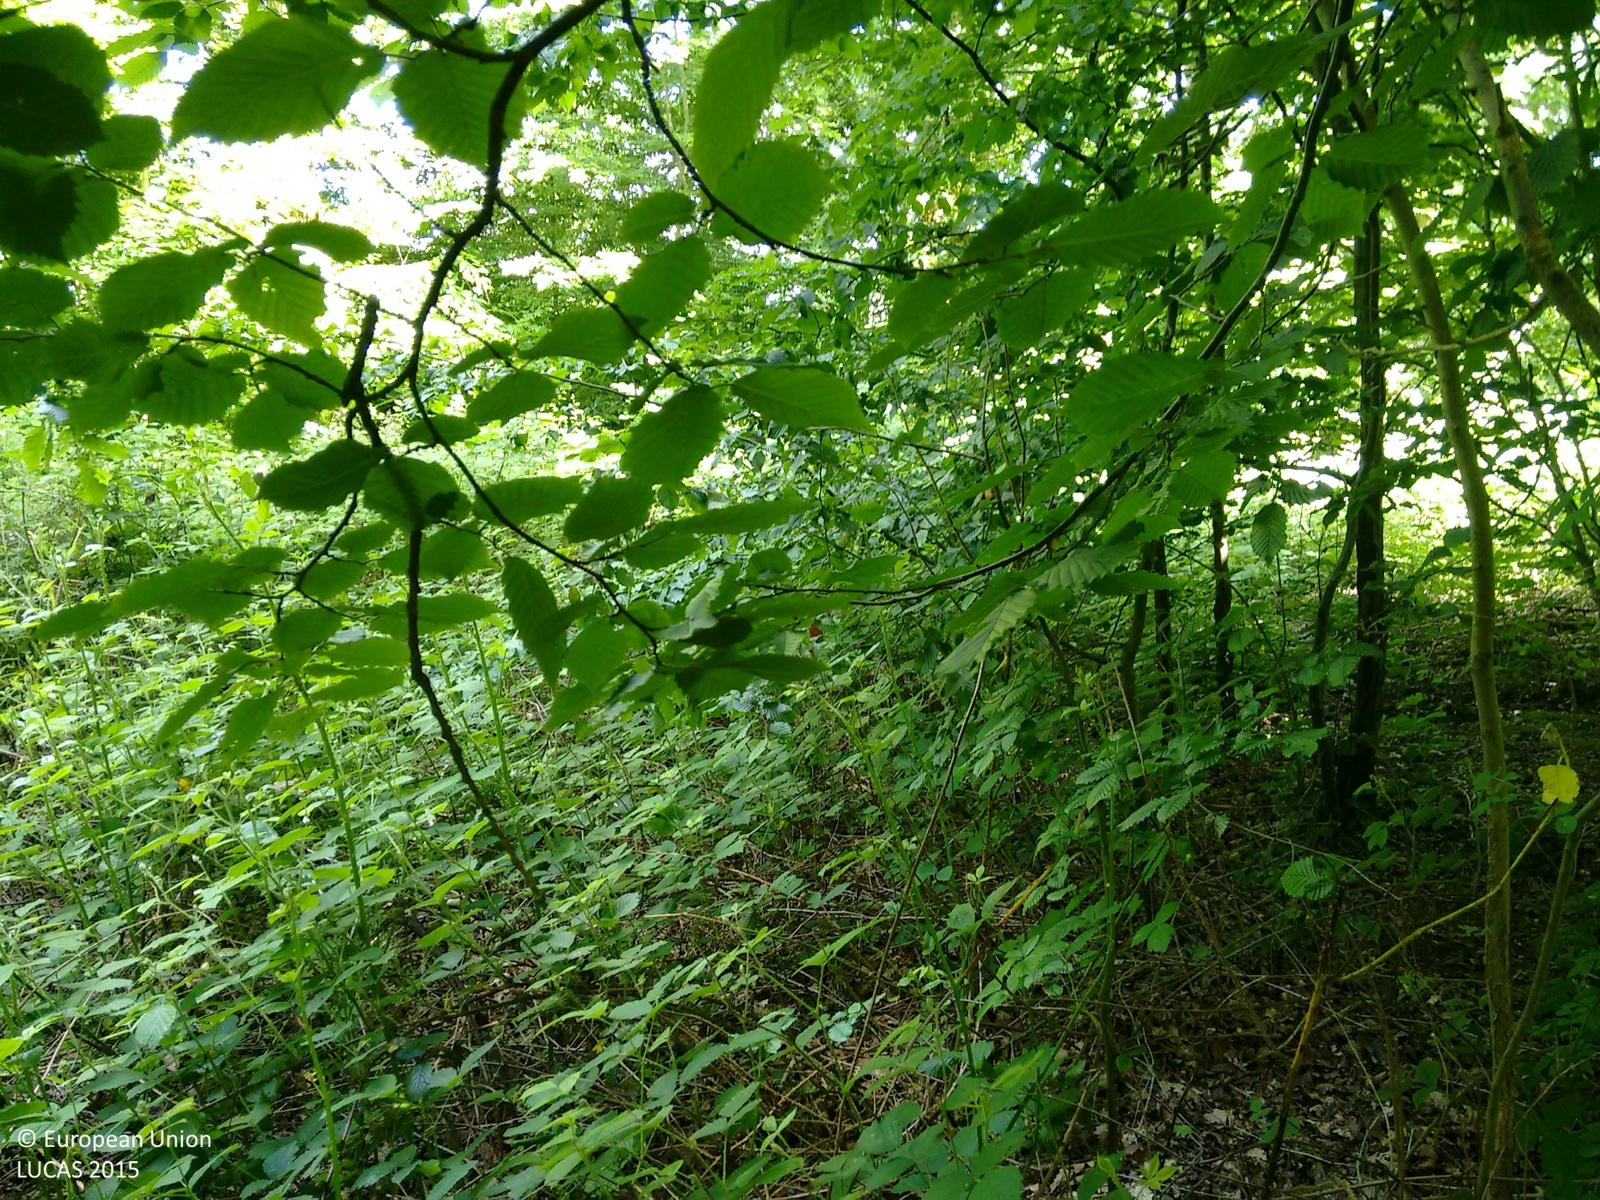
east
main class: Woodland
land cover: Broadleaved woodland
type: mesophytic deciduous forest
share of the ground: > 75 %
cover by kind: broadleaved forest trees 60 %, shrubs 35 %, herbaceous plants 5 %
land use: Forestry
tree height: > 5 m
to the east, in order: Broadleaved woodland; Fences; Grassland without tree/shrub cover; Lines of trees; Grassland without tree/shrub cover; Grassland with sparse tree/shrub cover; Grassland without tree/shrub cover
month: June
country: GB
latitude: 50.9578
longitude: 0.6485
